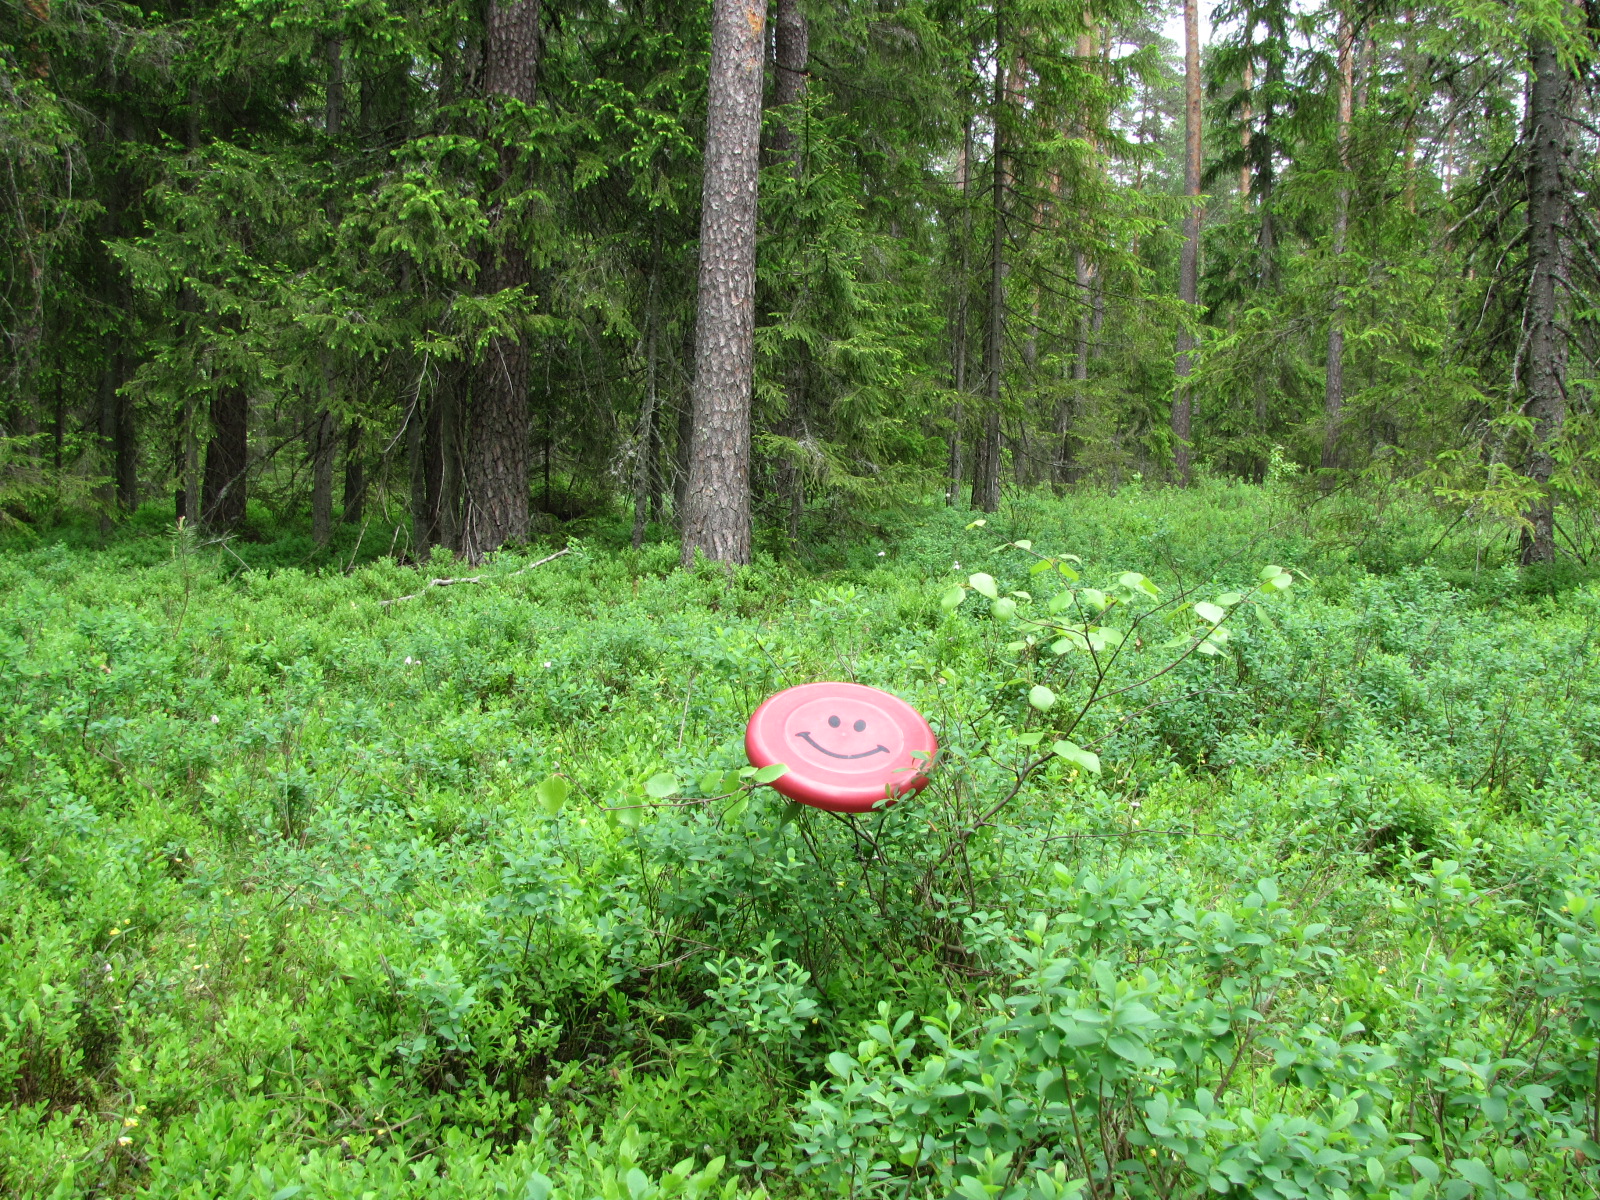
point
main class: Woodland
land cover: Other coniferous woodland
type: hemiboreal forest and nemoral coniferous forest and mixed broadleaved-coniferous forest
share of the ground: 50 - 75 %
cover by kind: coniferous forest trees 50 %, herbaceous plants 40 %, lichens and mosses 10 %
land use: Forestry
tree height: > 5 m
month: June
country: LV
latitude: 56.9530
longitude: 24.4801
